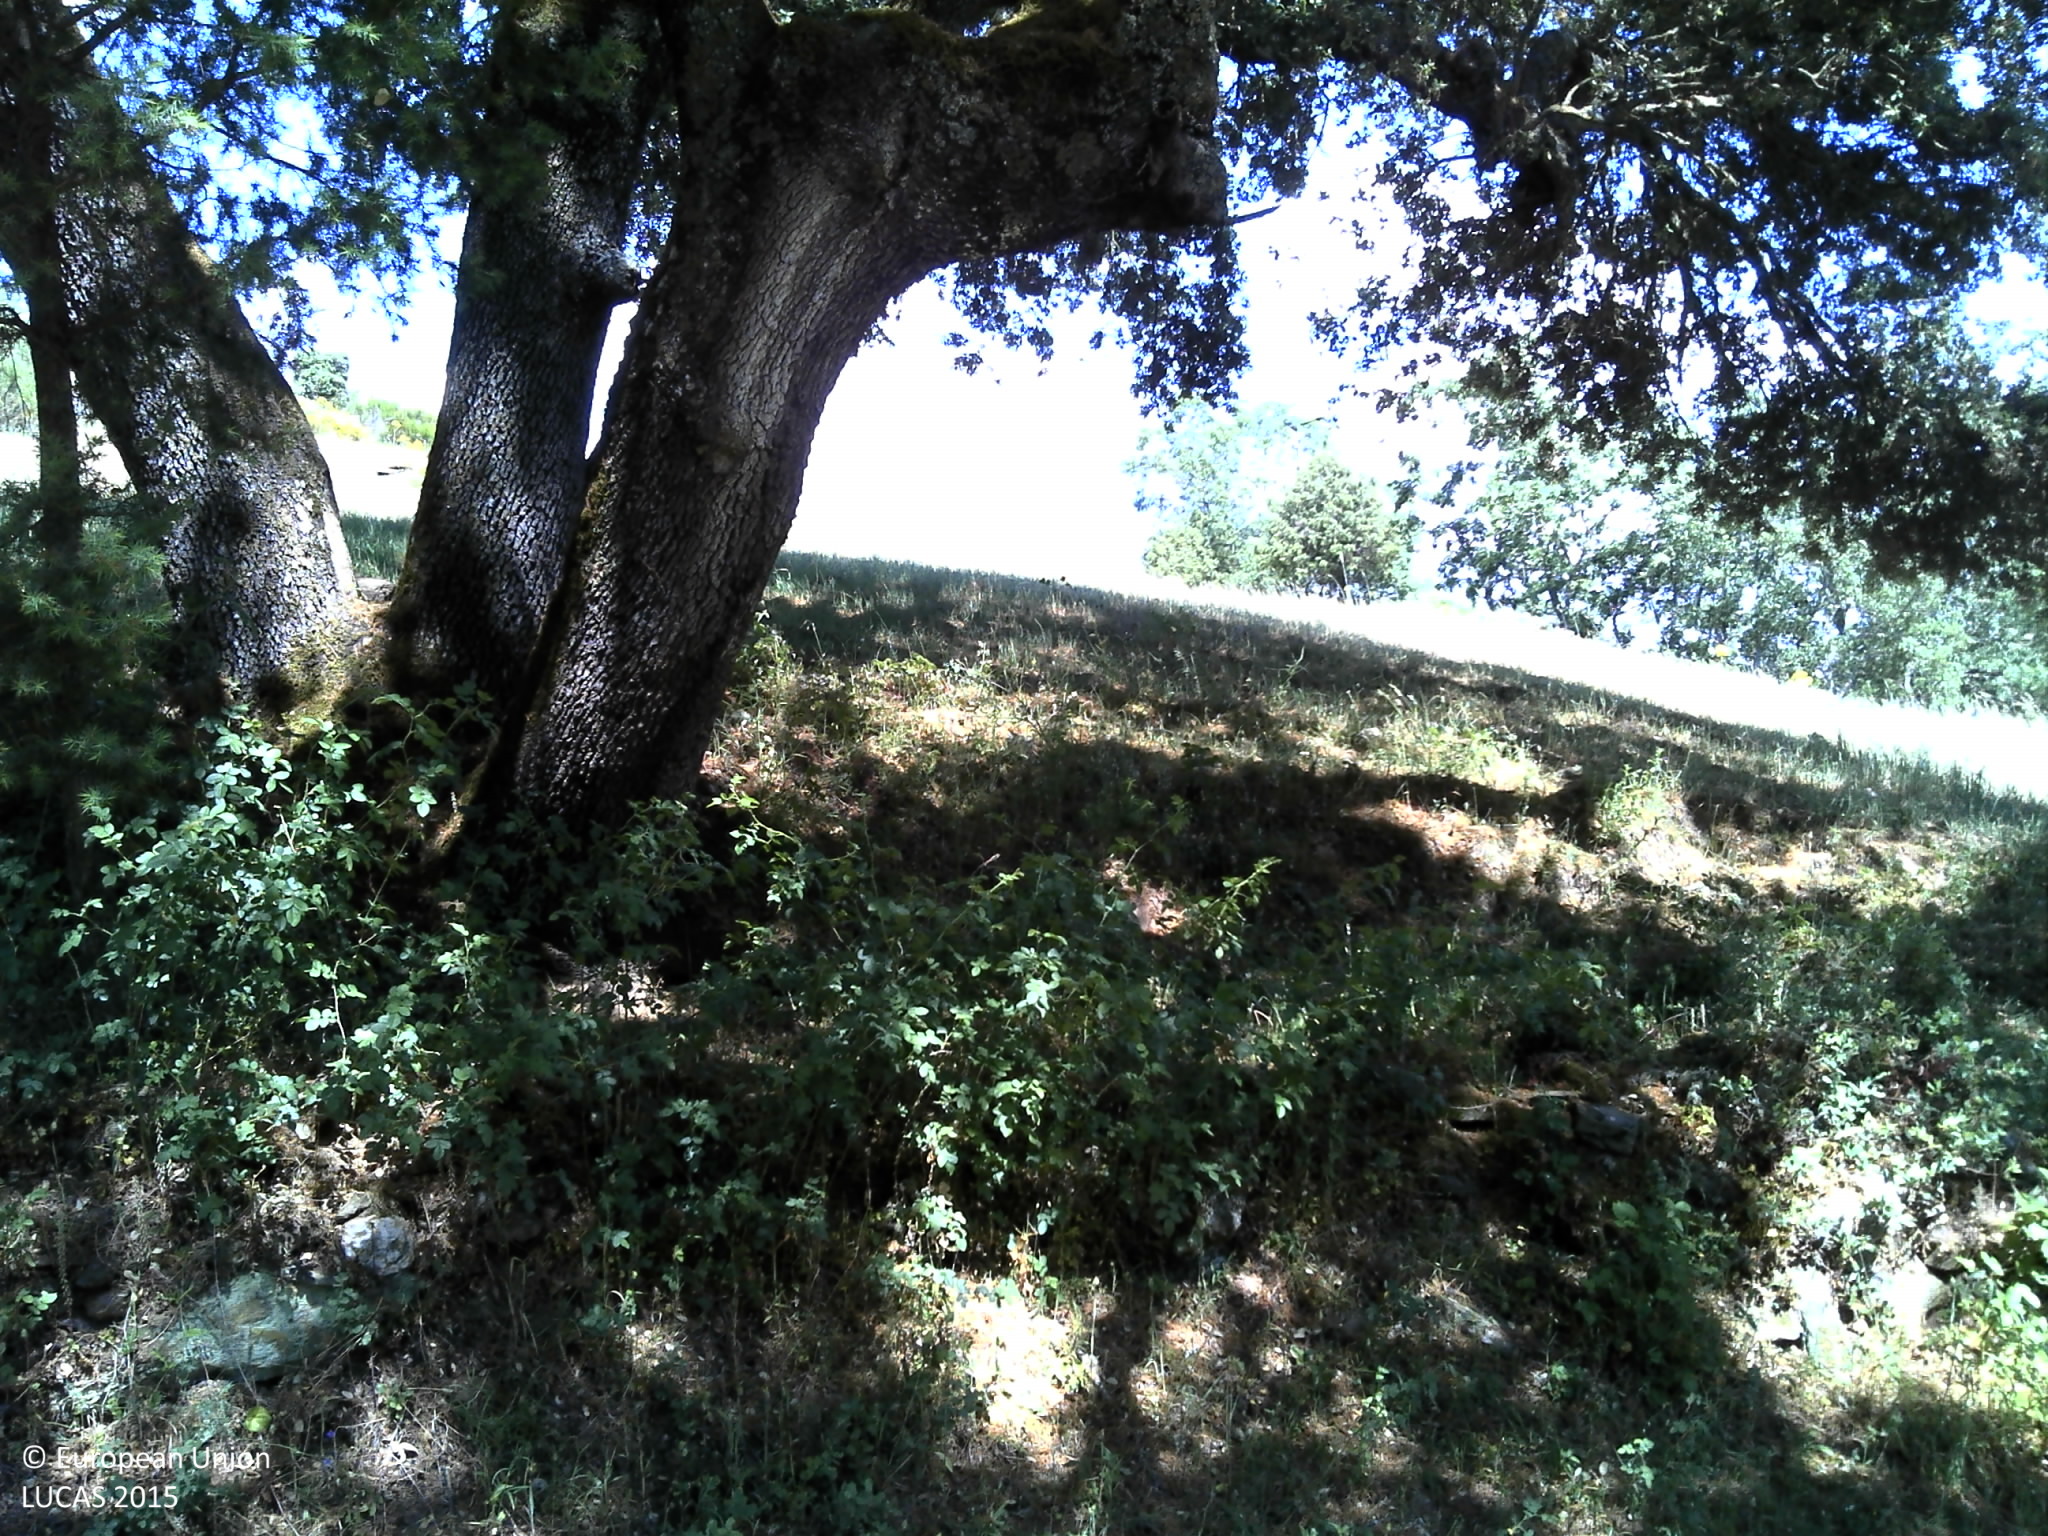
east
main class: Woodland
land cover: Broadleaved woodland
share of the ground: 50 - 75 %
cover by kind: broadleaved forest trees 60 %, herbaceous plants 30 %, unconsolidated bare surface 10 %
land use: Forestry
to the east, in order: Broadleaved woodland; Grassland without tree/shrub cover; Dry stone walls; Grassland with sparse tree/shrub cover; Oats; Groves; Oats; Dry stone walls; Spontaneously vegetated surfaces; Dry stone walls; Spontaneously vegetated surfaces; Dry stone walls; Broadleaved woodland; Dry stone walls; Abandoned hedges; Grassland without tree/shrub cover; Abandoned hedges; Dry stone walls; Grassland without tree/shrub cover; Shruby margins; Dry stone walls; Grassland without tree/shrub cover; Single bushes/trees; Dry stone walls; Grassland with sparse tree/shrub cover
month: May
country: PT
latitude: 41.5779
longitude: -6.2050
